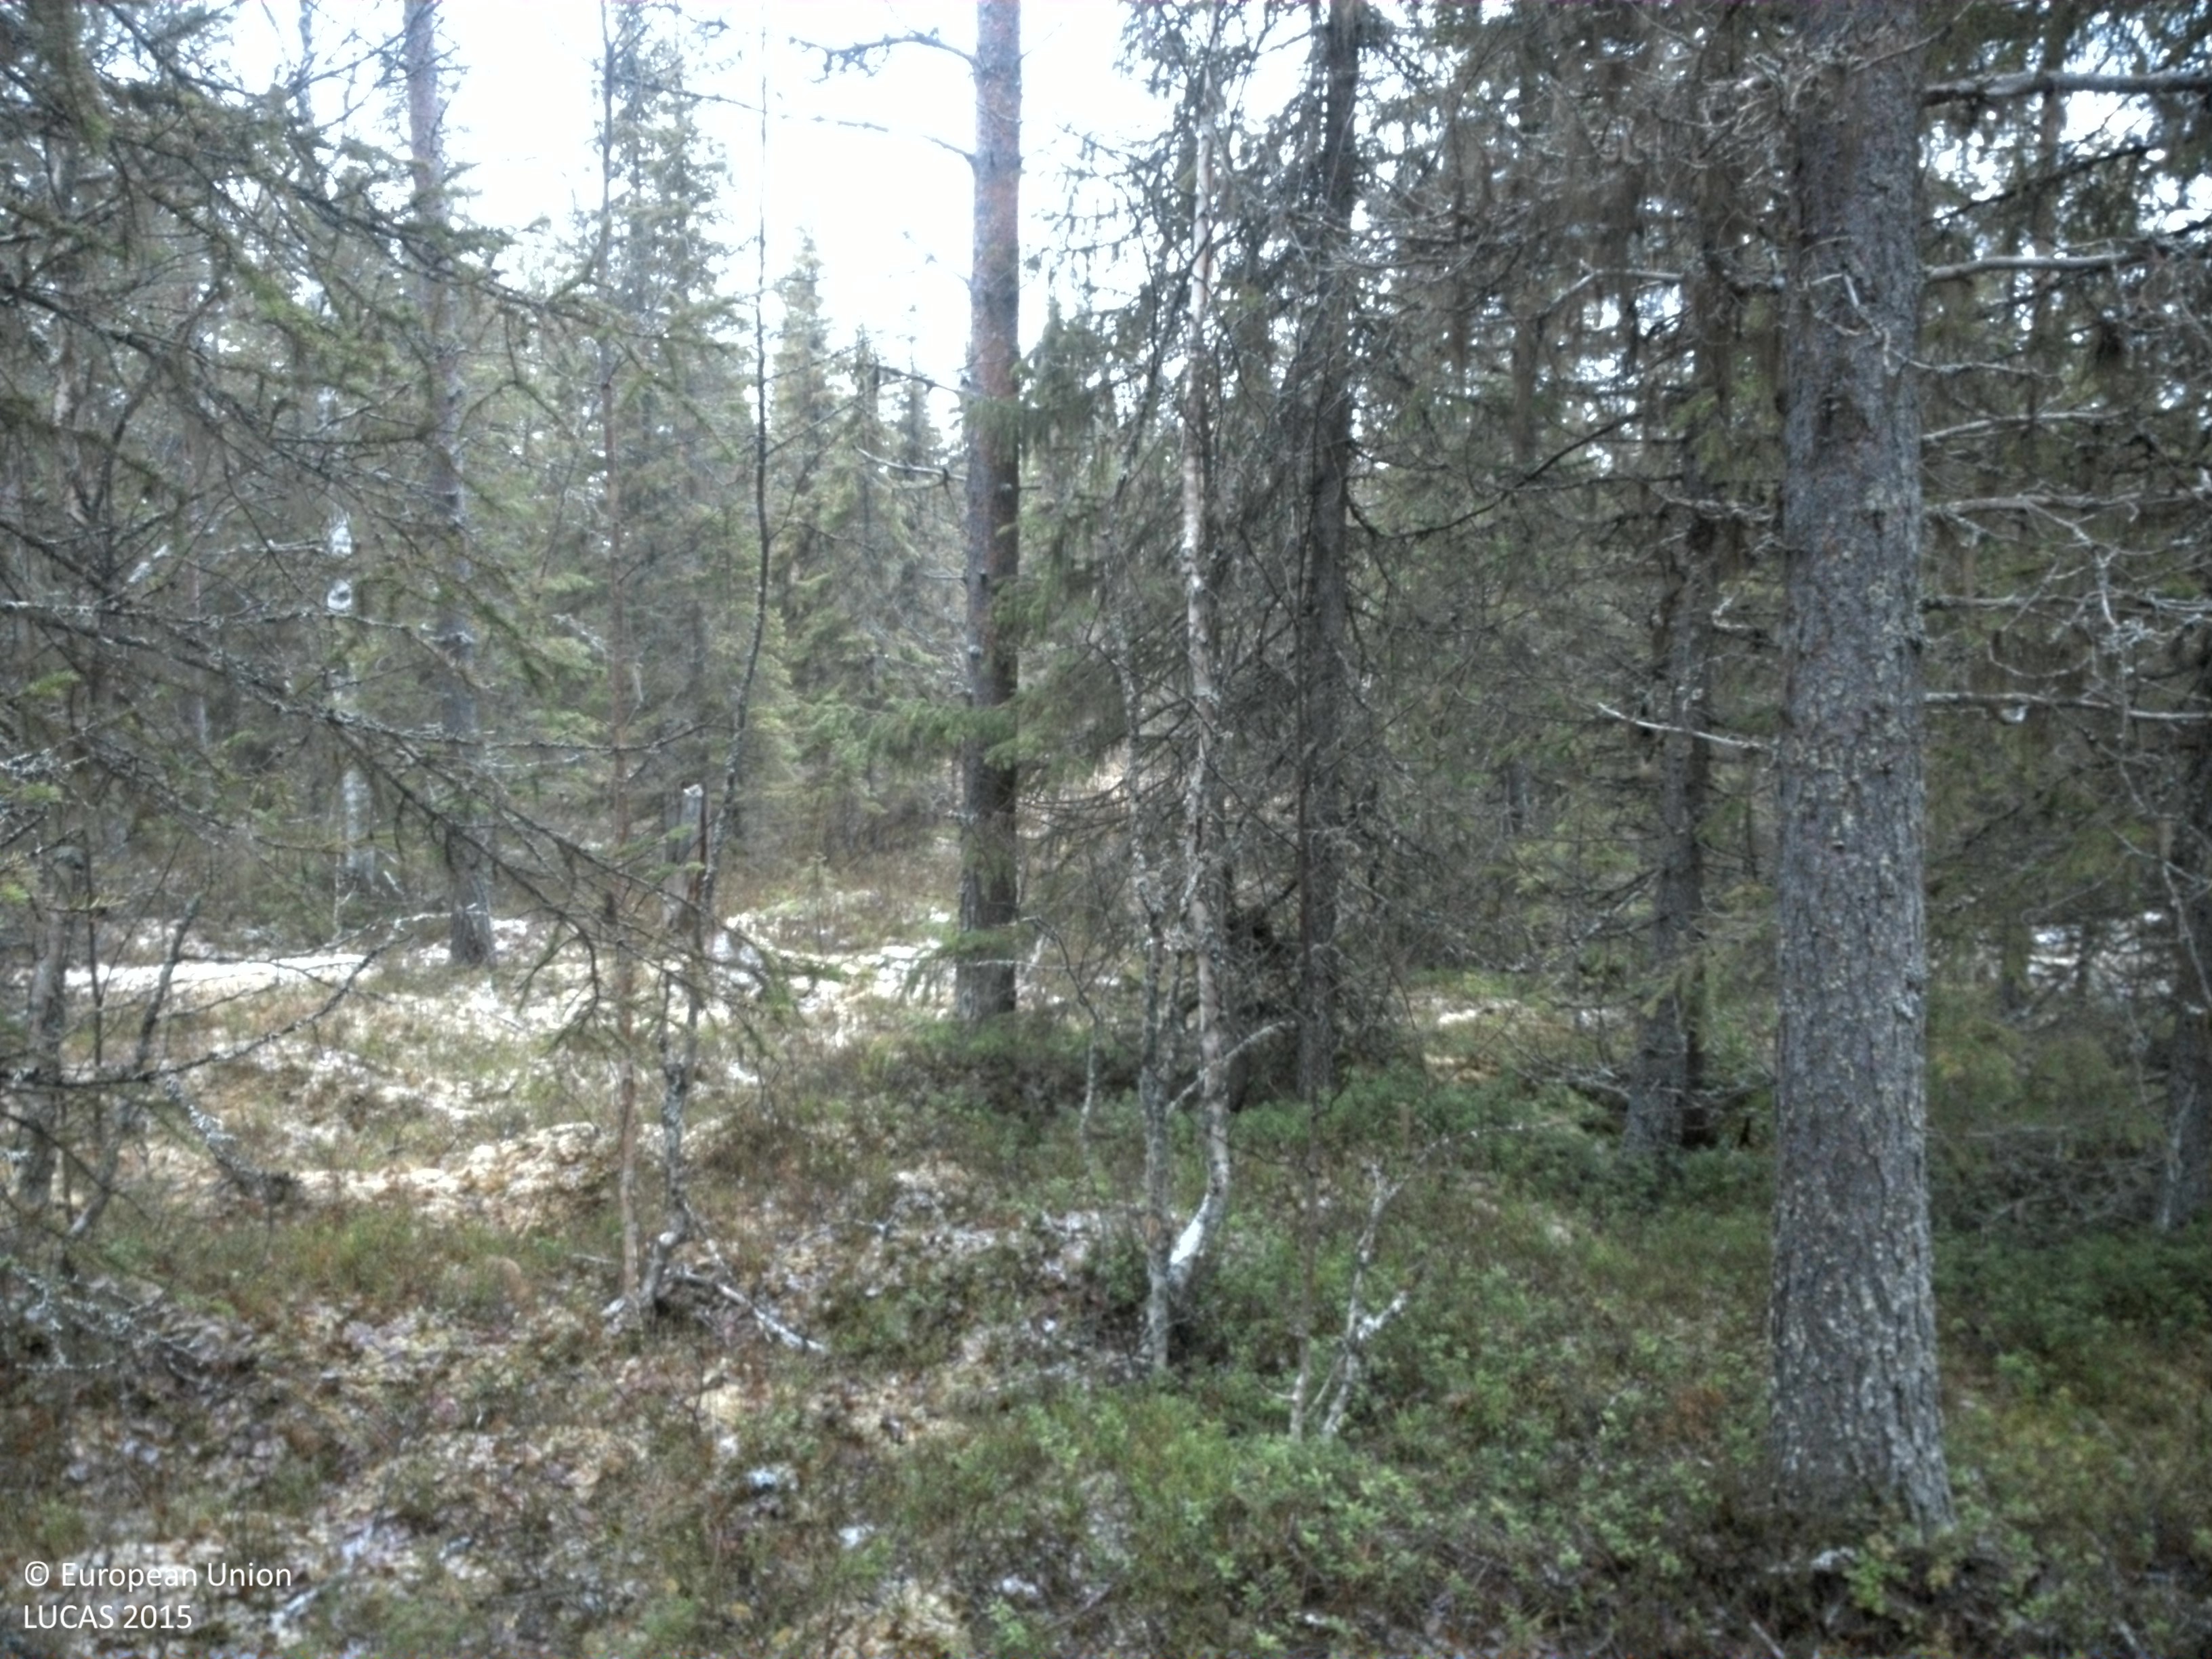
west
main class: Woodland
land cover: Other coniferous woodland
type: boreal forest
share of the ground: 25 - 50 %
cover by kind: coniferous forest trees 35 %, shrubs 35 %, lichens and mosses 20 %, broadleaved forest trees 5 %, herbaceous plants 5 %
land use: Forestry
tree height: > 5 m
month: October
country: SE
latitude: 64.3636
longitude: 16.7423
